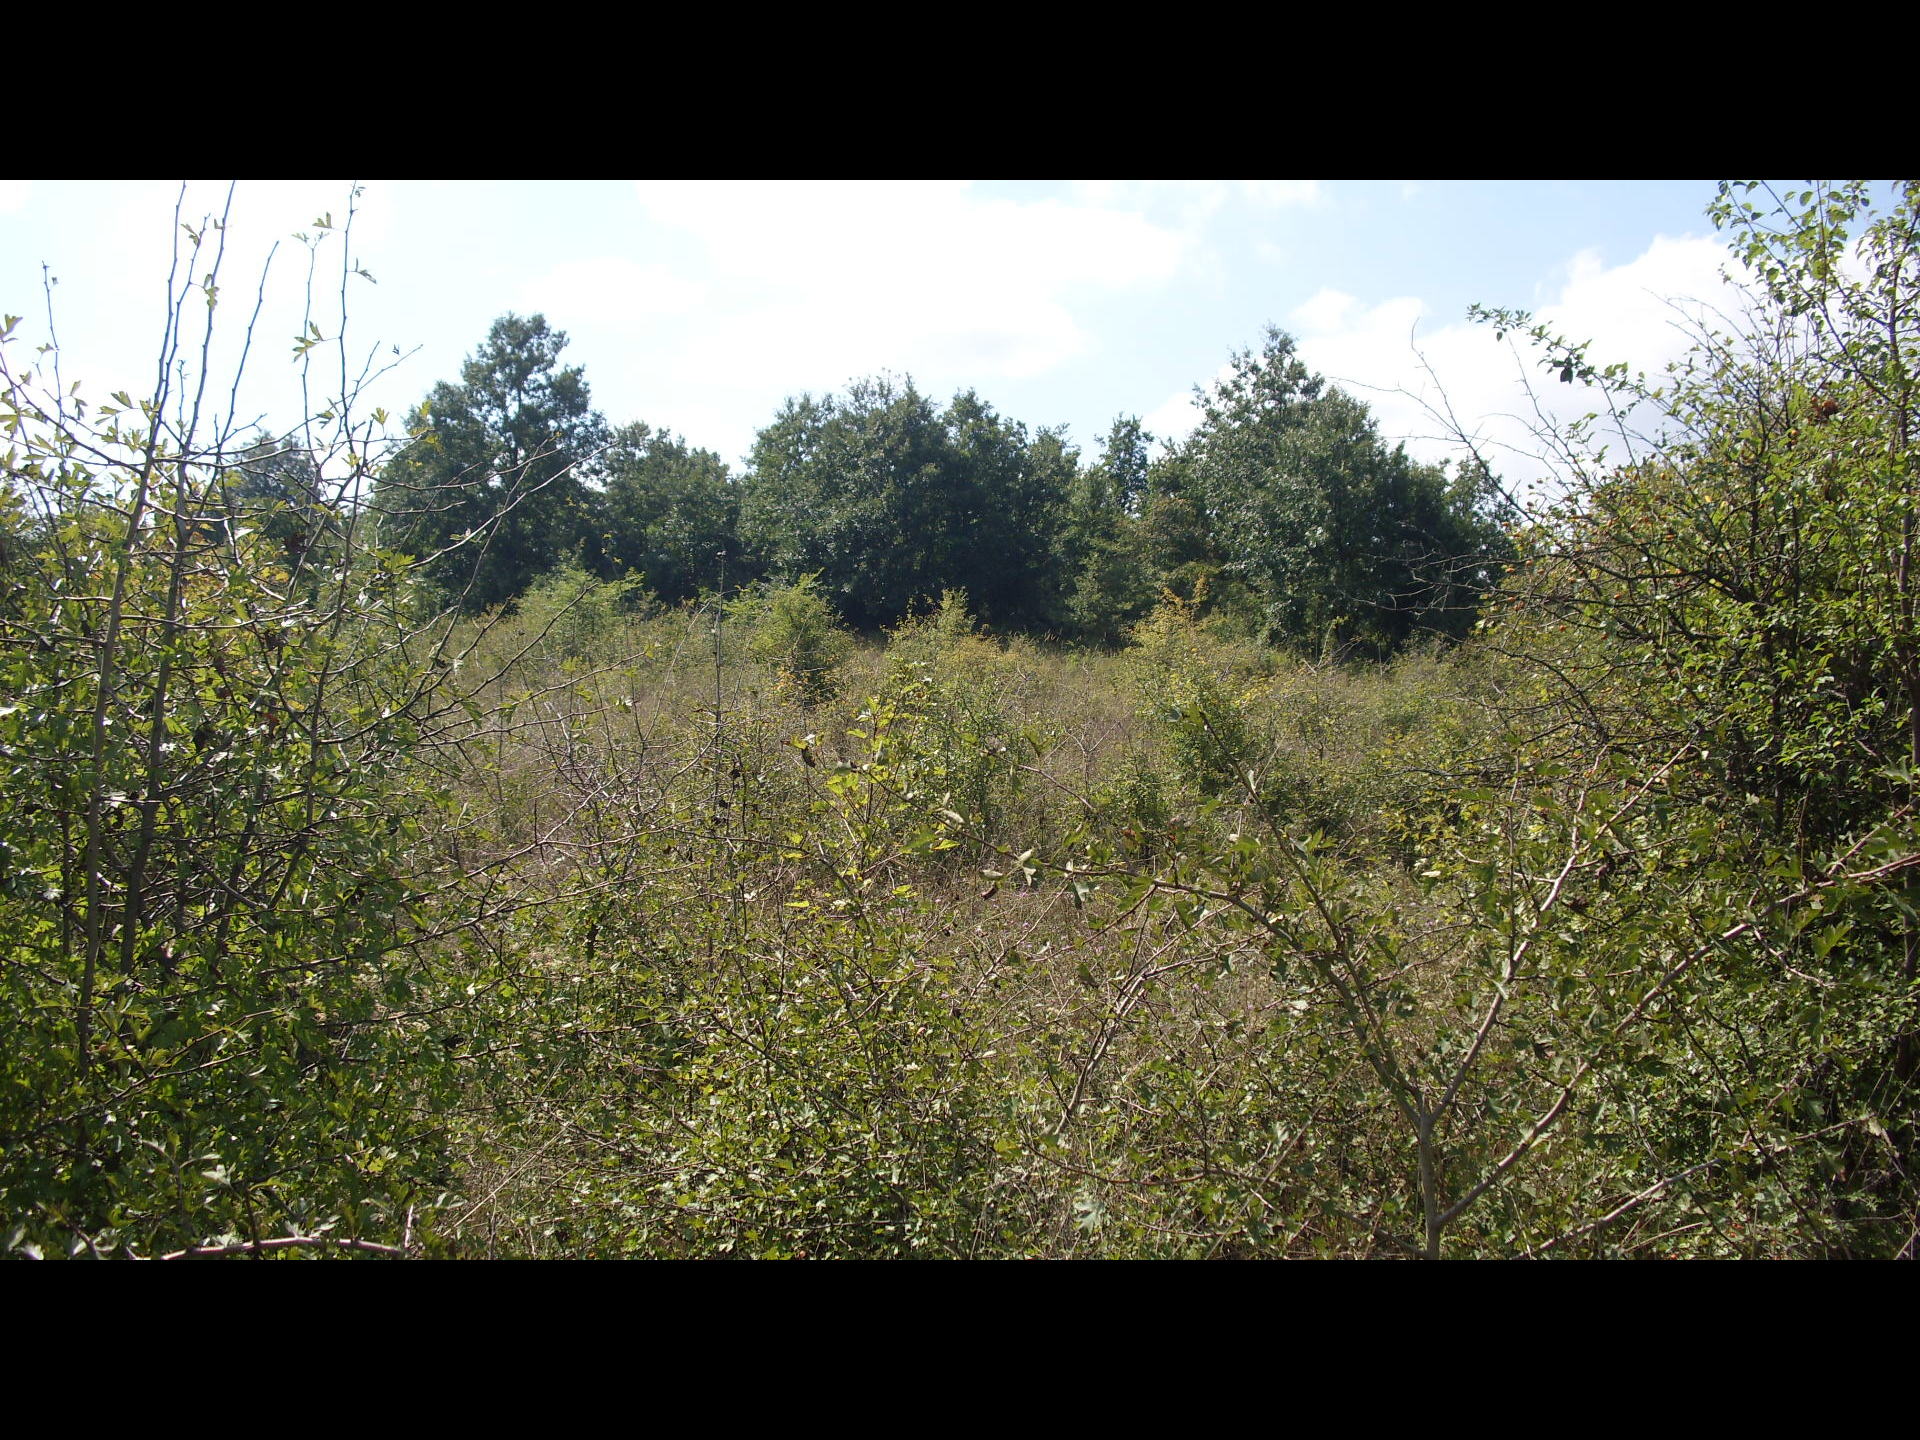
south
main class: Grassland
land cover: Grassland with sparse tree/shrub cover
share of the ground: > 75 %
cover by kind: herbaceous plants 85 %, shrubs 10 %, broadleaved forest trees 5 %
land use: Agriculture (excluding fallow land and kitchen gardens)
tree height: < 5 m
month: August
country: BG
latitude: 43.4933
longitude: 23.1348
